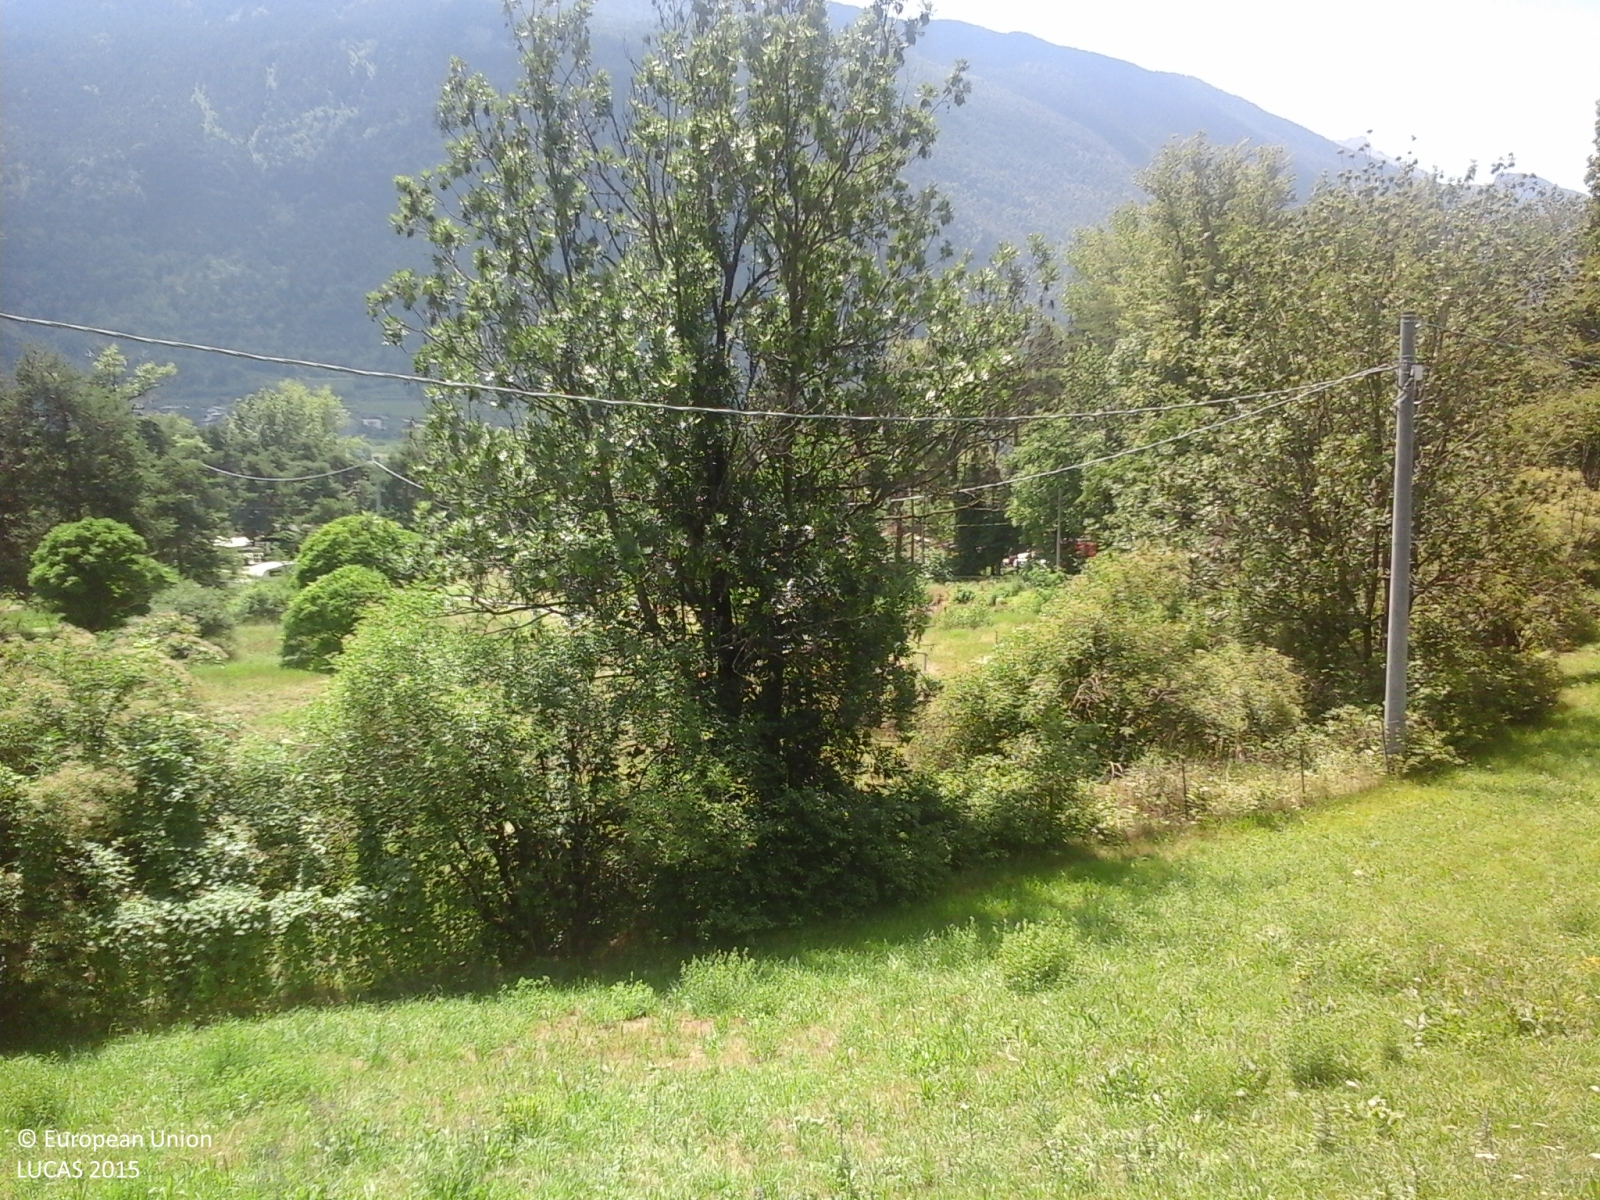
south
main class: Grassland
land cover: Grassland without tree/shrub cover
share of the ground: > 75 %
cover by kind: herbaceous plants 85 %, unconsolidated bare surface 15 %
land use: Agriculture (excluding fallow land and kitchen gardens)
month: June
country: IT
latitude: 45.7215
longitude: 7.2671
